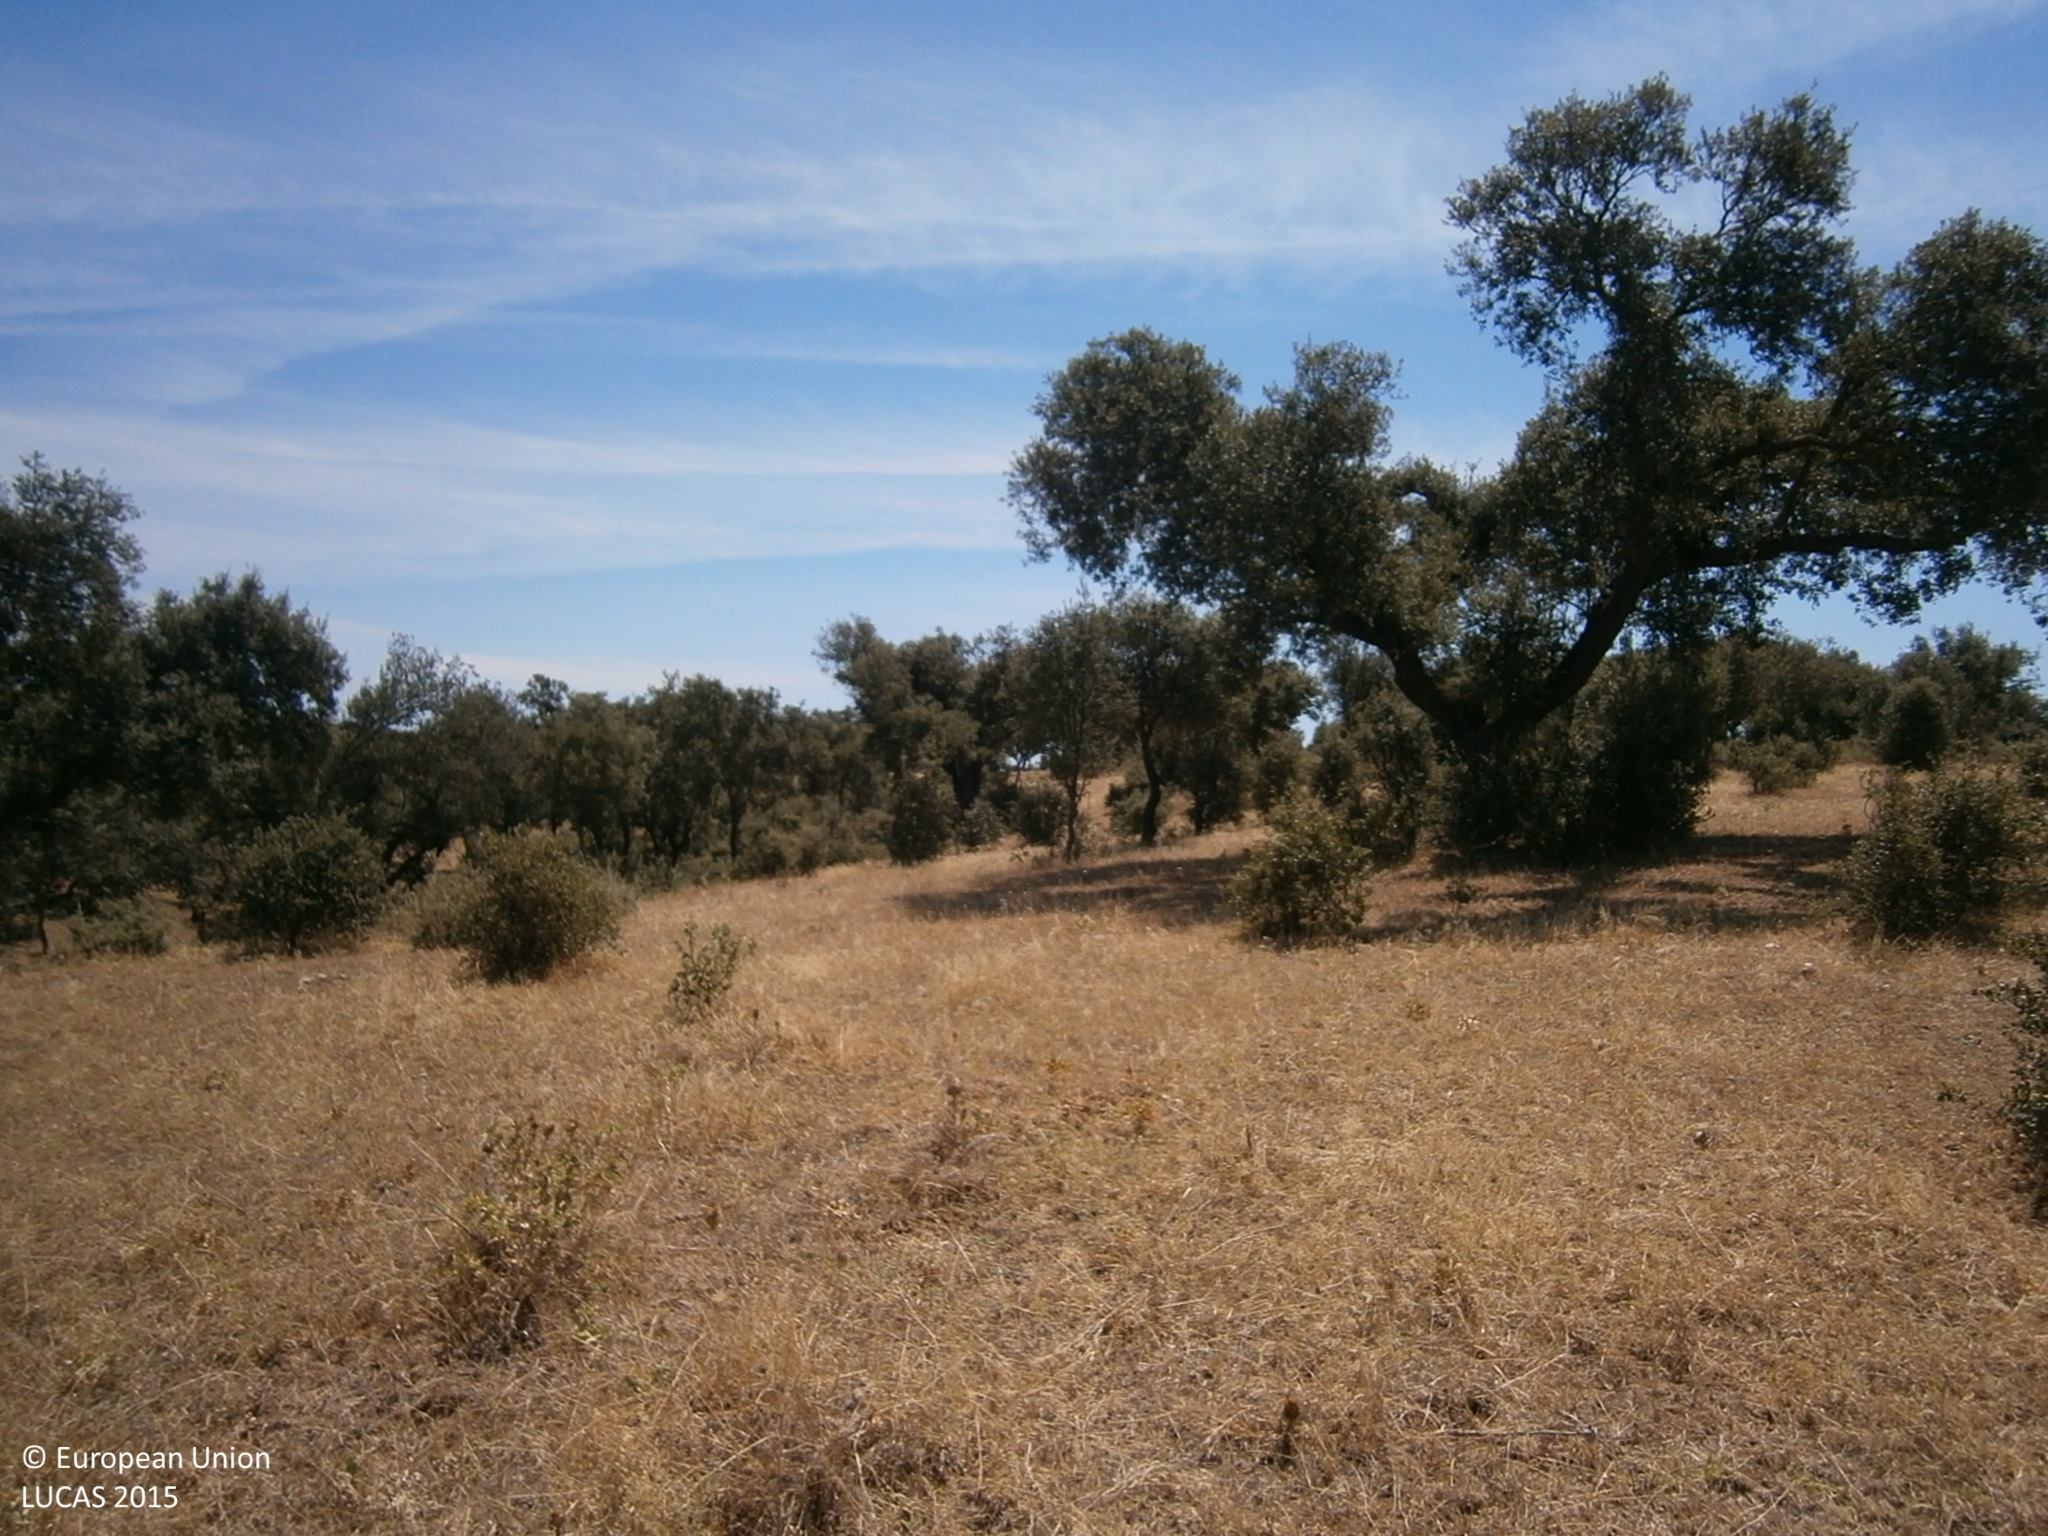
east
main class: Grassland
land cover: Grassland with sparse tree/shrub cover
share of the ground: > 75 %
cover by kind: herbaceous plants 90 %, broadleaved forest trees 5 %, shrubs 5 %
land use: Agriculture (excluding fallow land and kitchen gardens)
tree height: > 5 m
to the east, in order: Grassland with sparse tree/shrub cover; Broadleaved woodland; Tracks; Broadleaved woodland; Fences; Spontaneously vegetated surfaces
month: July
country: ES
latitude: 38.6430
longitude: -7.2008
